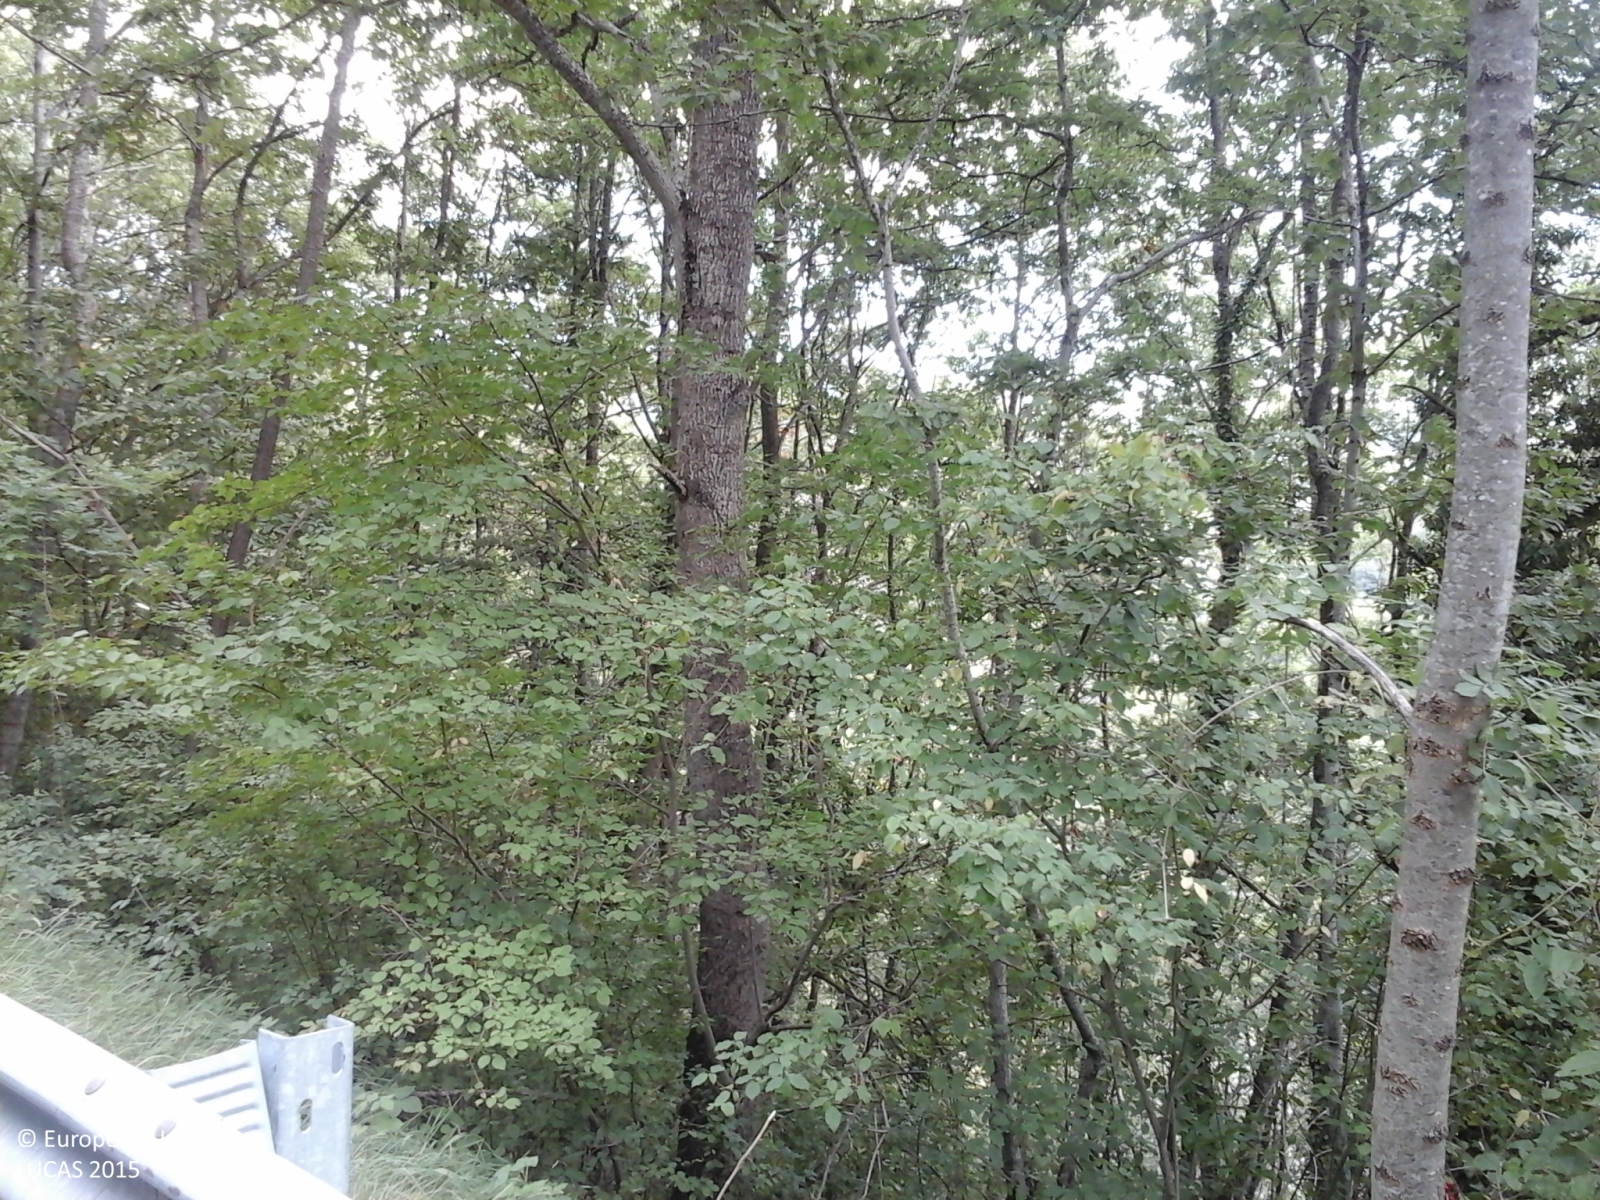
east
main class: Woodland
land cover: Broadleaved woodland
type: thermophilous deciduous forest
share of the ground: > 75 %
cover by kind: broadleaved forest trees 80 %, shrubs 10 %, herbaceous plants 10 %
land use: Forestry
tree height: > 5 m
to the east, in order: Broadleaved woodland; Rivers and streams; Electric lines; Broadleaved woodland
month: September
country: IT
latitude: 42.5588
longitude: 13.4607
